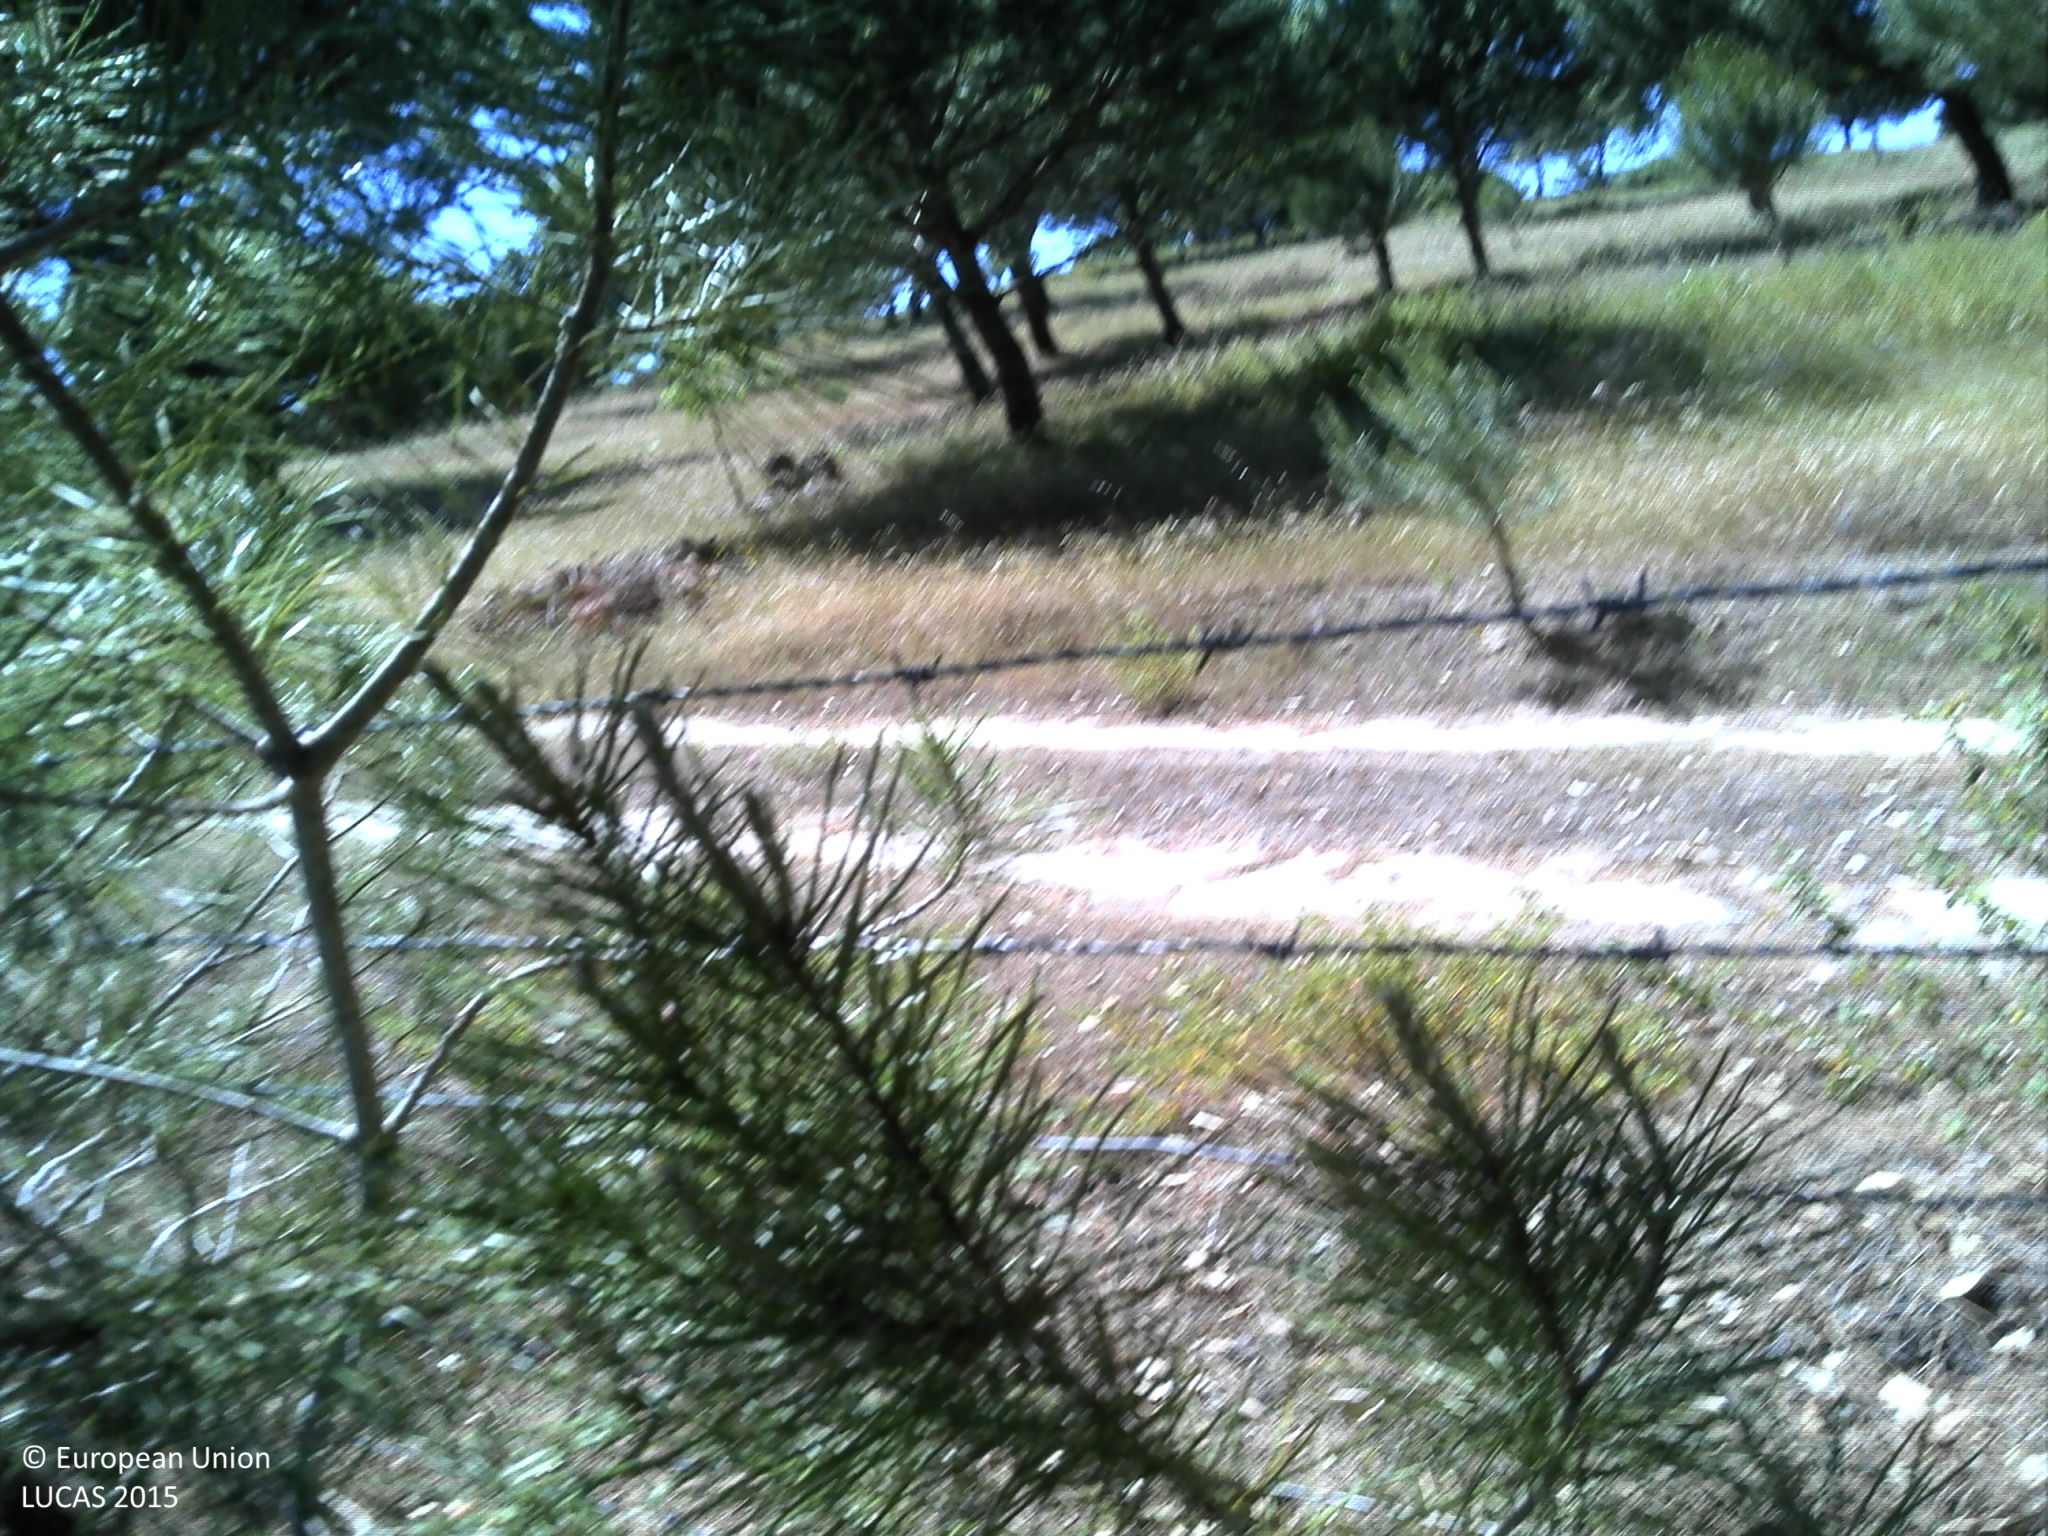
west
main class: Woodland
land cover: Pine dominated coniferous woodland
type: coniferous forest of the mediterranean region
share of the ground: 10 - 25 %
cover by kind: herbaceous plants 60 %, coniferous forest trees 20 %, unconsolidated bare surface 20 %
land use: Forestry
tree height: > 5 m
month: May
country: PT
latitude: 38.6001
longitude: -8.5073
